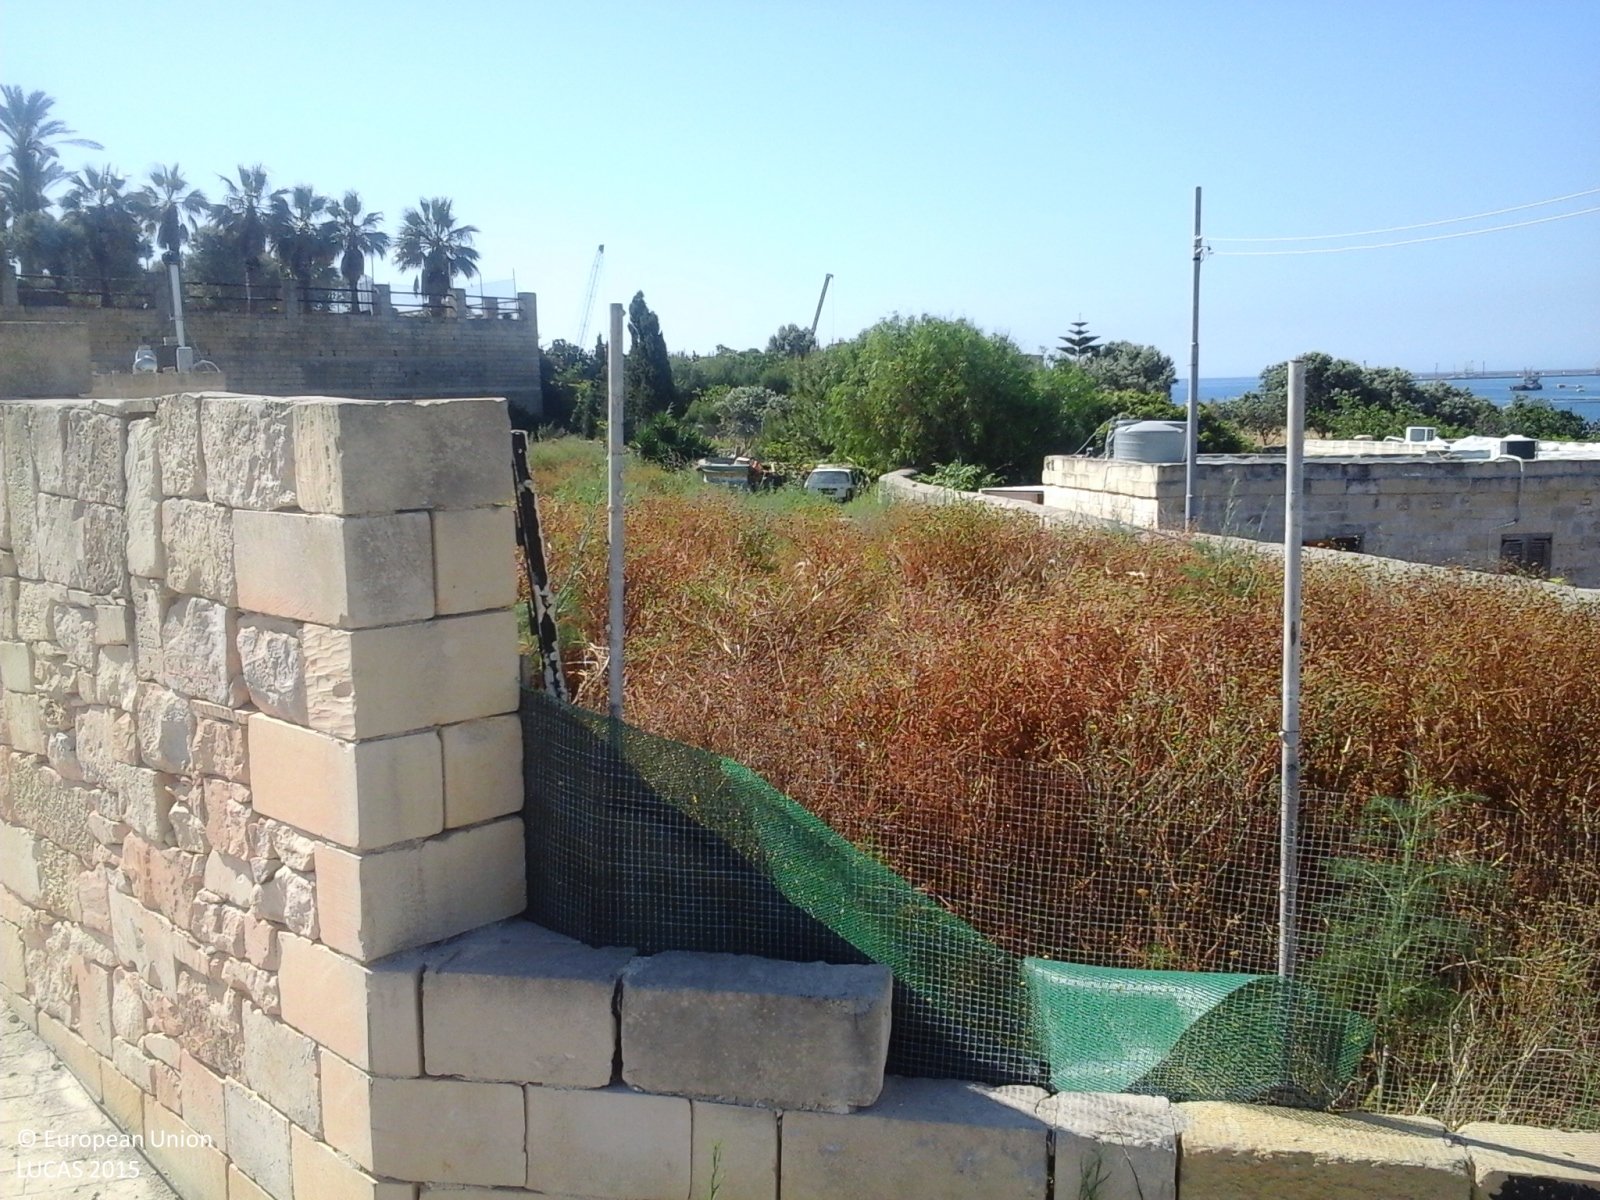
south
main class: Grassland
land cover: Grassland without tree/shrub cover
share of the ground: > 75 %
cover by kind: herbaceous plants 60 %, shrubs 5 %
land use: Abandoned areas
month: May
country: MT
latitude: 35.8368
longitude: 14.5521
